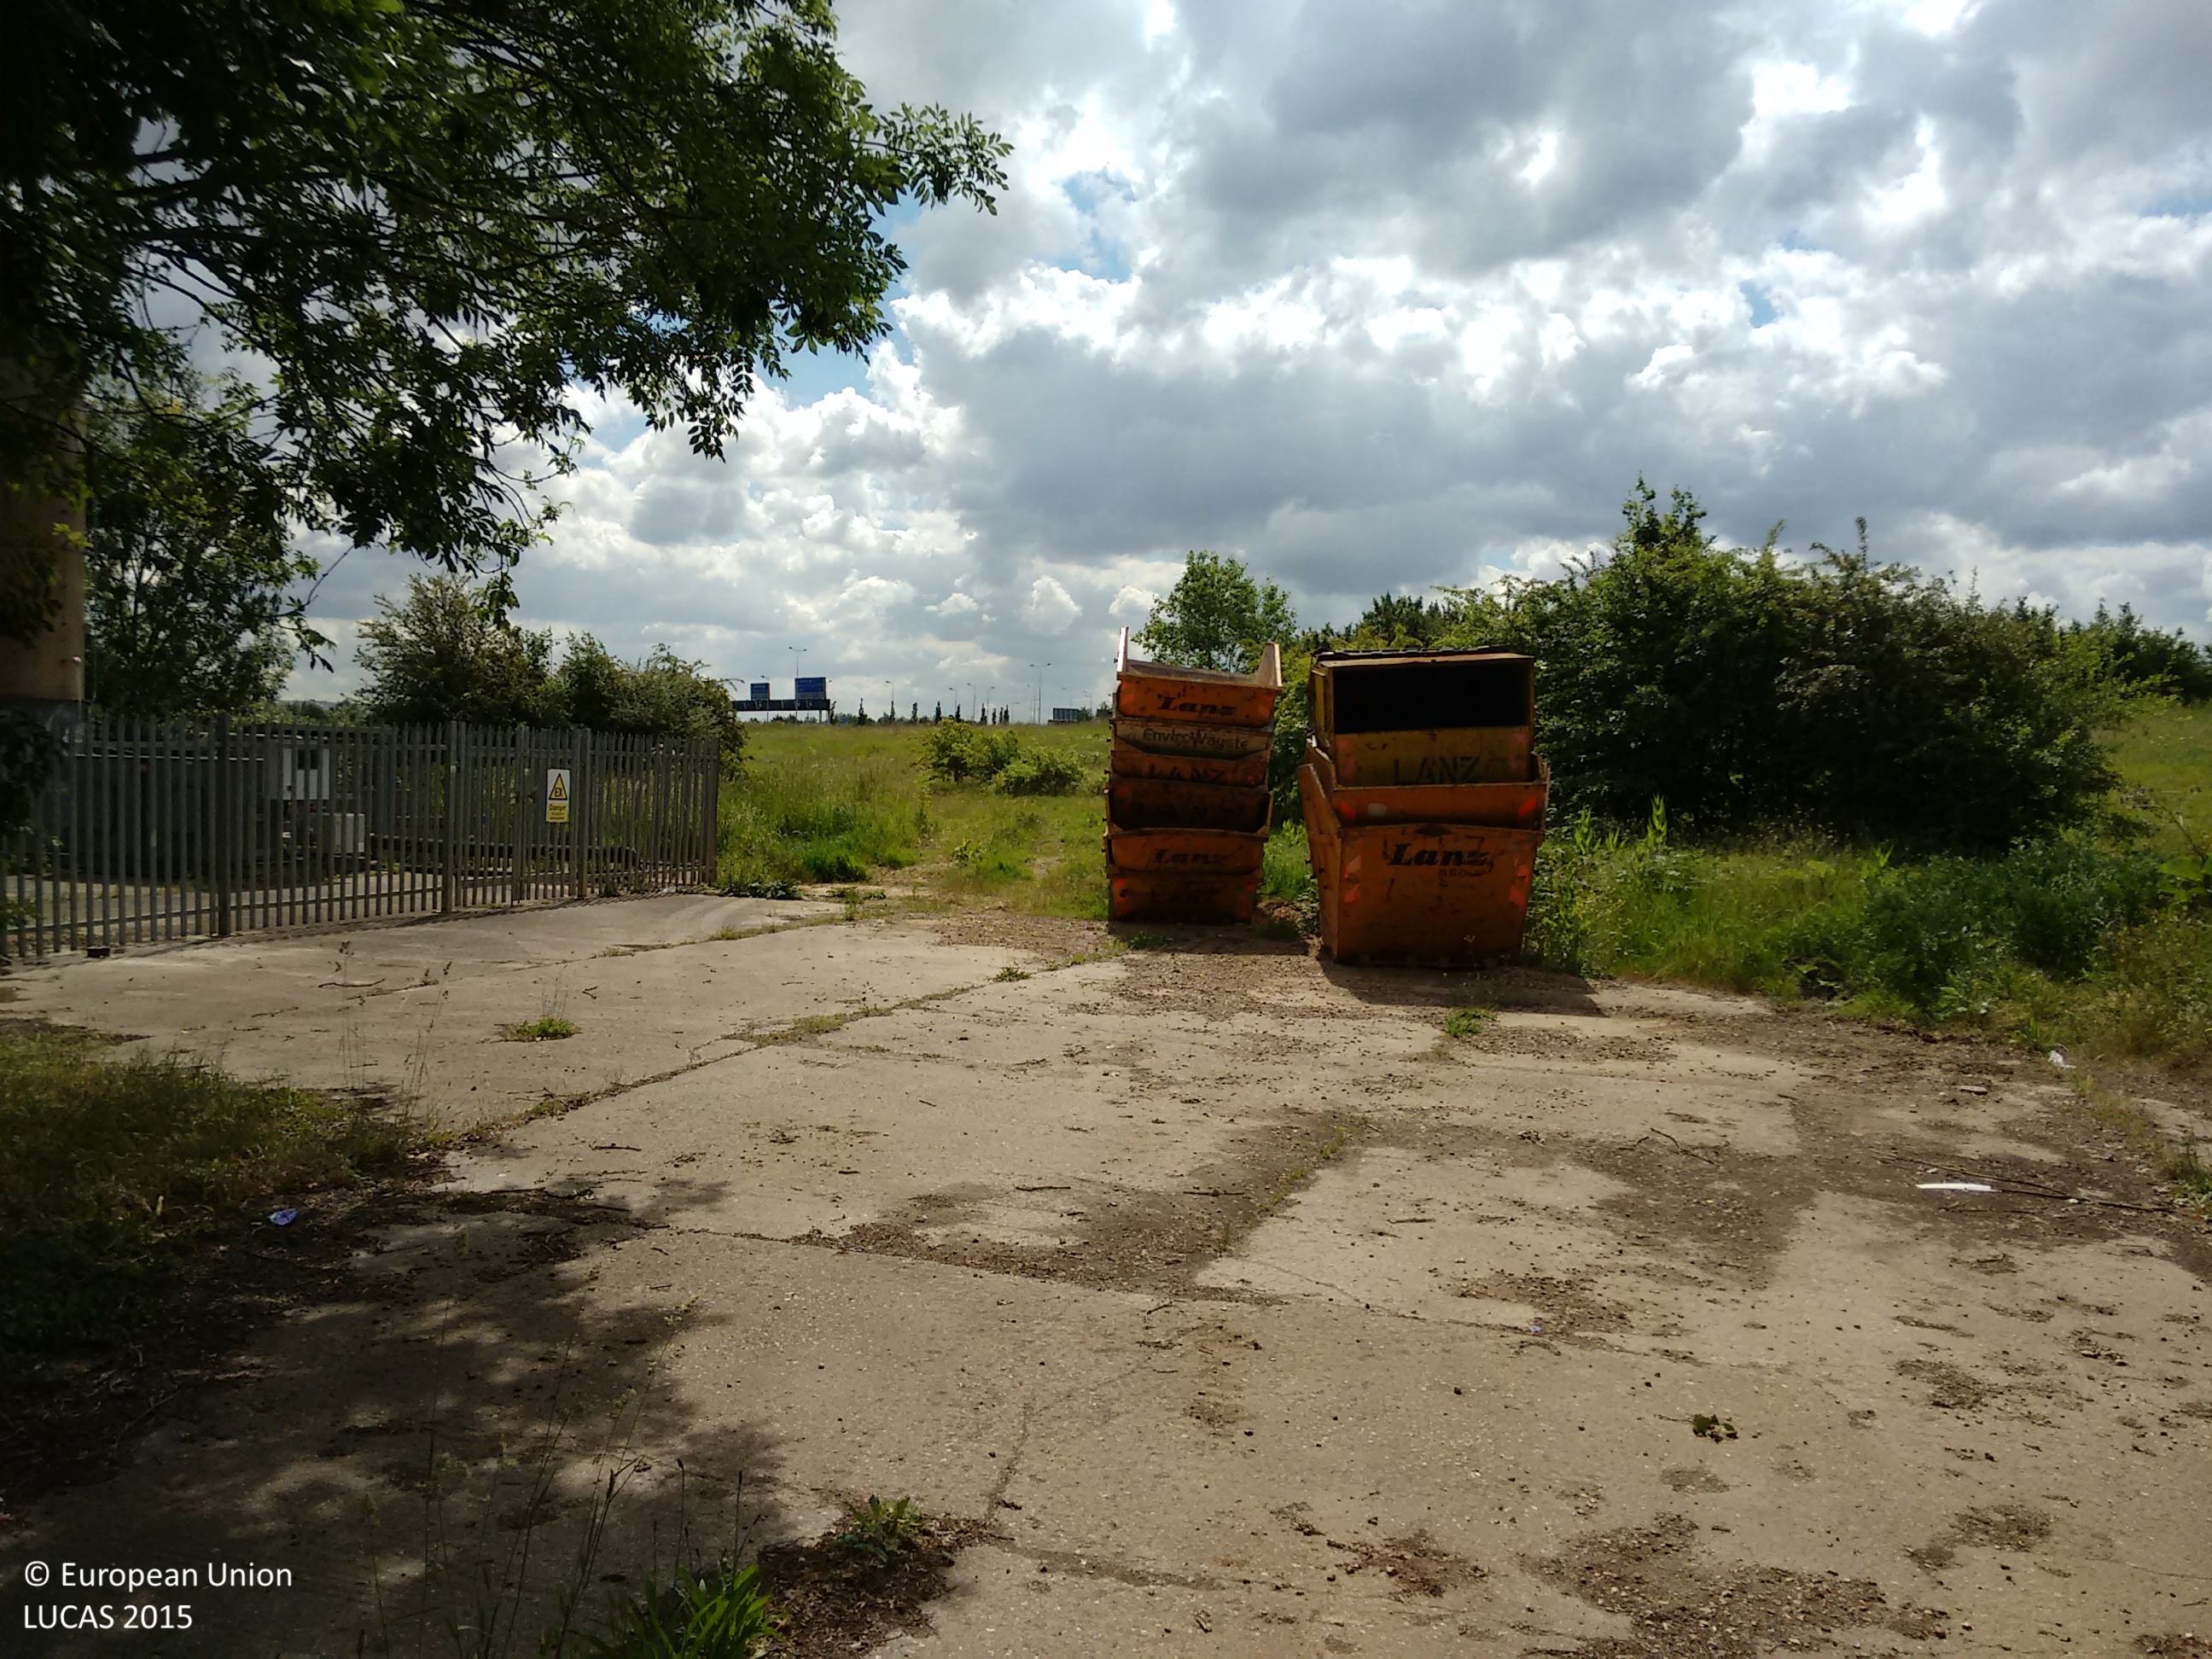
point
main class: Grassland
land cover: Grassland with sparse tree/shrub cover
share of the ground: > 75 %
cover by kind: herbaceous plants 95 %, broadleaved forest trees 5 %
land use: Semi-natural and natural areas not in use
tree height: < 5 m
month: June
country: GB
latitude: 51.4748
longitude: -0.5055
